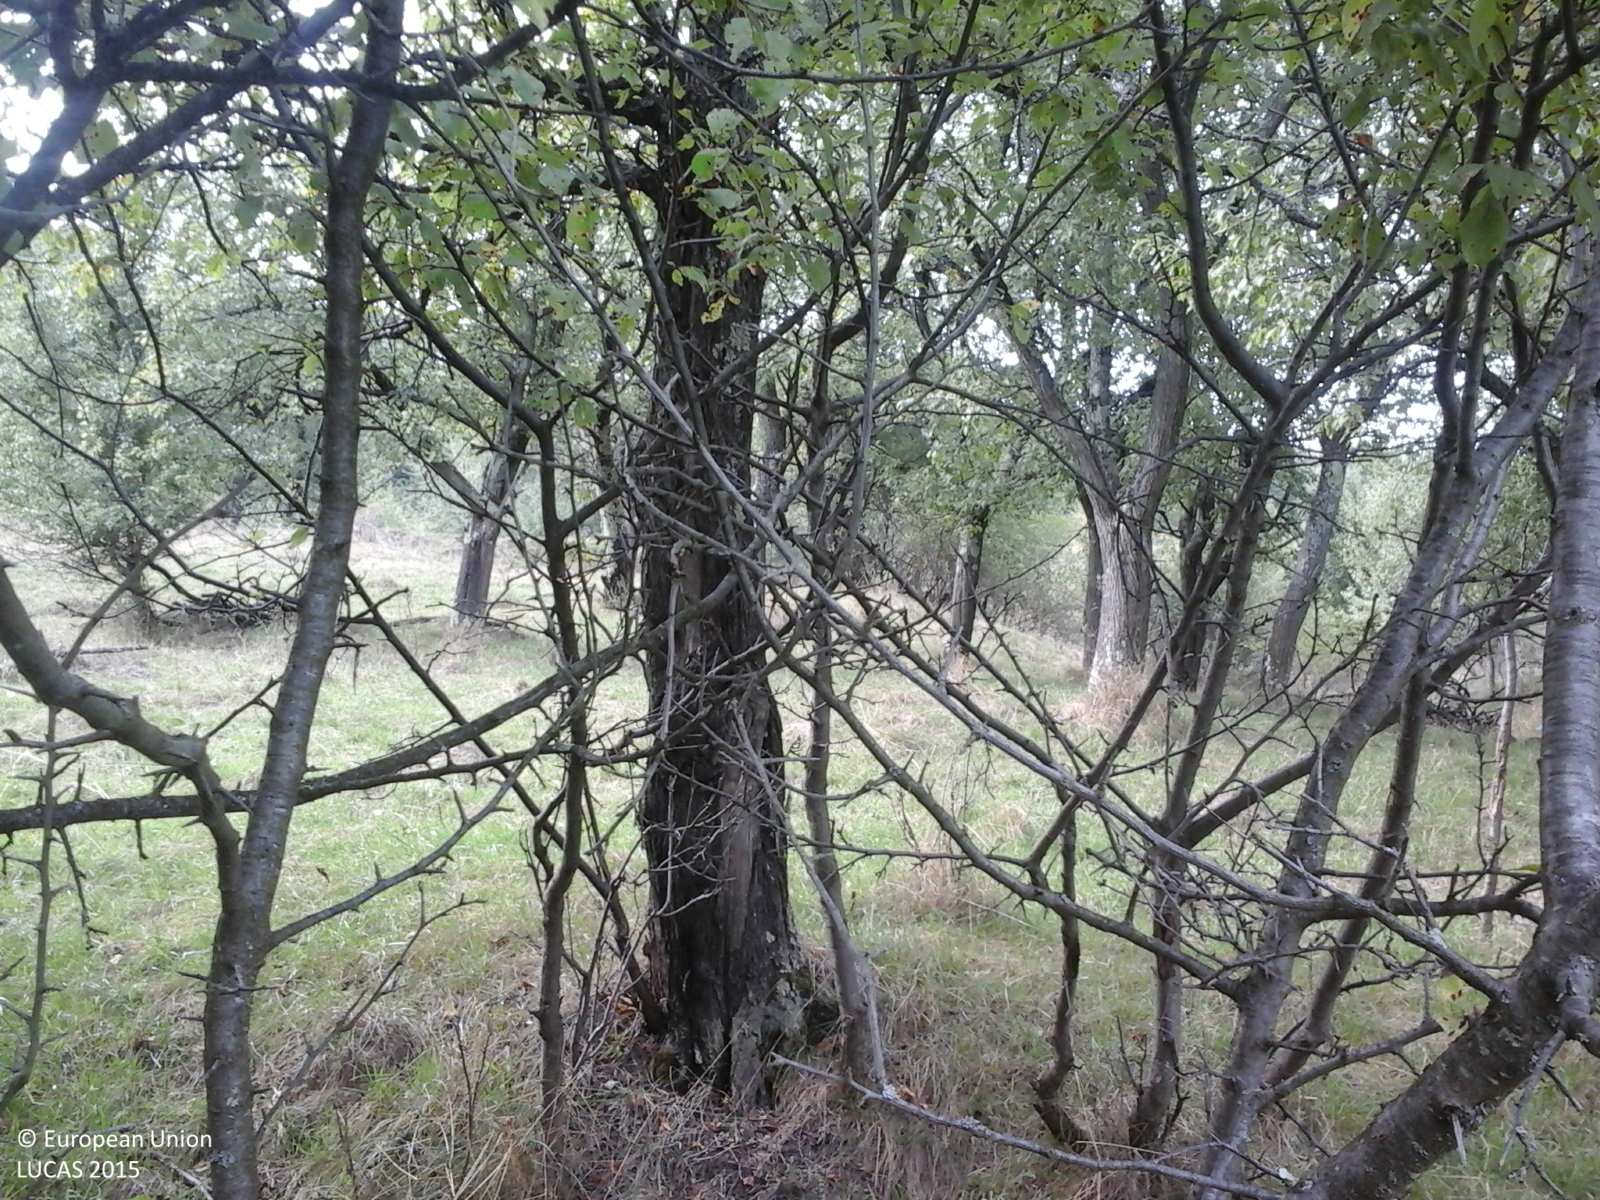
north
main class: Grassland
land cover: Grassland with sparse tree/shrub cover
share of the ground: > 75 %
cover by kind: herbaceous plants 85 %, shrubs 10 %, broadleaved forest trees 5 %
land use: Agriculture (excluding fallow land and kitchen gardens)
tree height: < 5 m
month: September
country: RO
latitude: 47.1485
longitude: 23.3759
